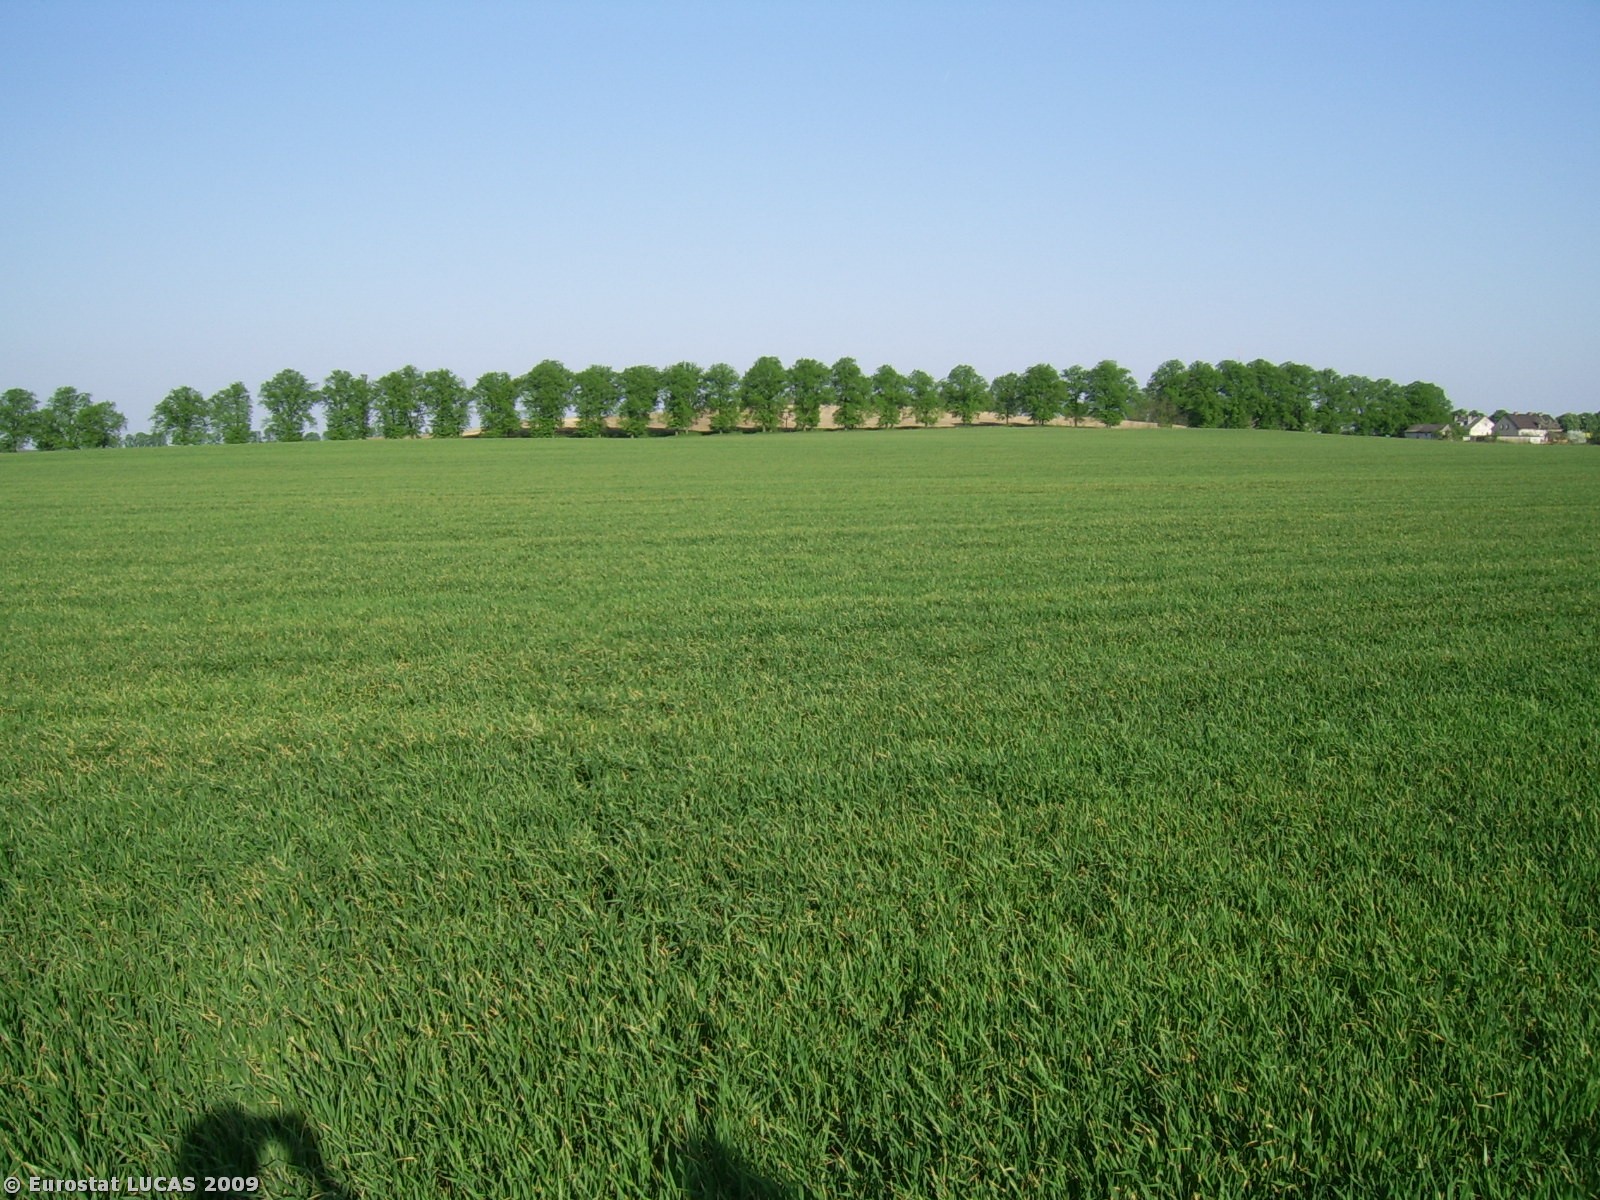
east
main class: Cropland
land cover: Common wheat
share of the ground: > 75 %
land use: Agriculture (excluding fallow land and kitchen gardens)
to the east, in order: Common wheat
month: April
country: PL
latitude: 52.1394
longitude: 16.9207
